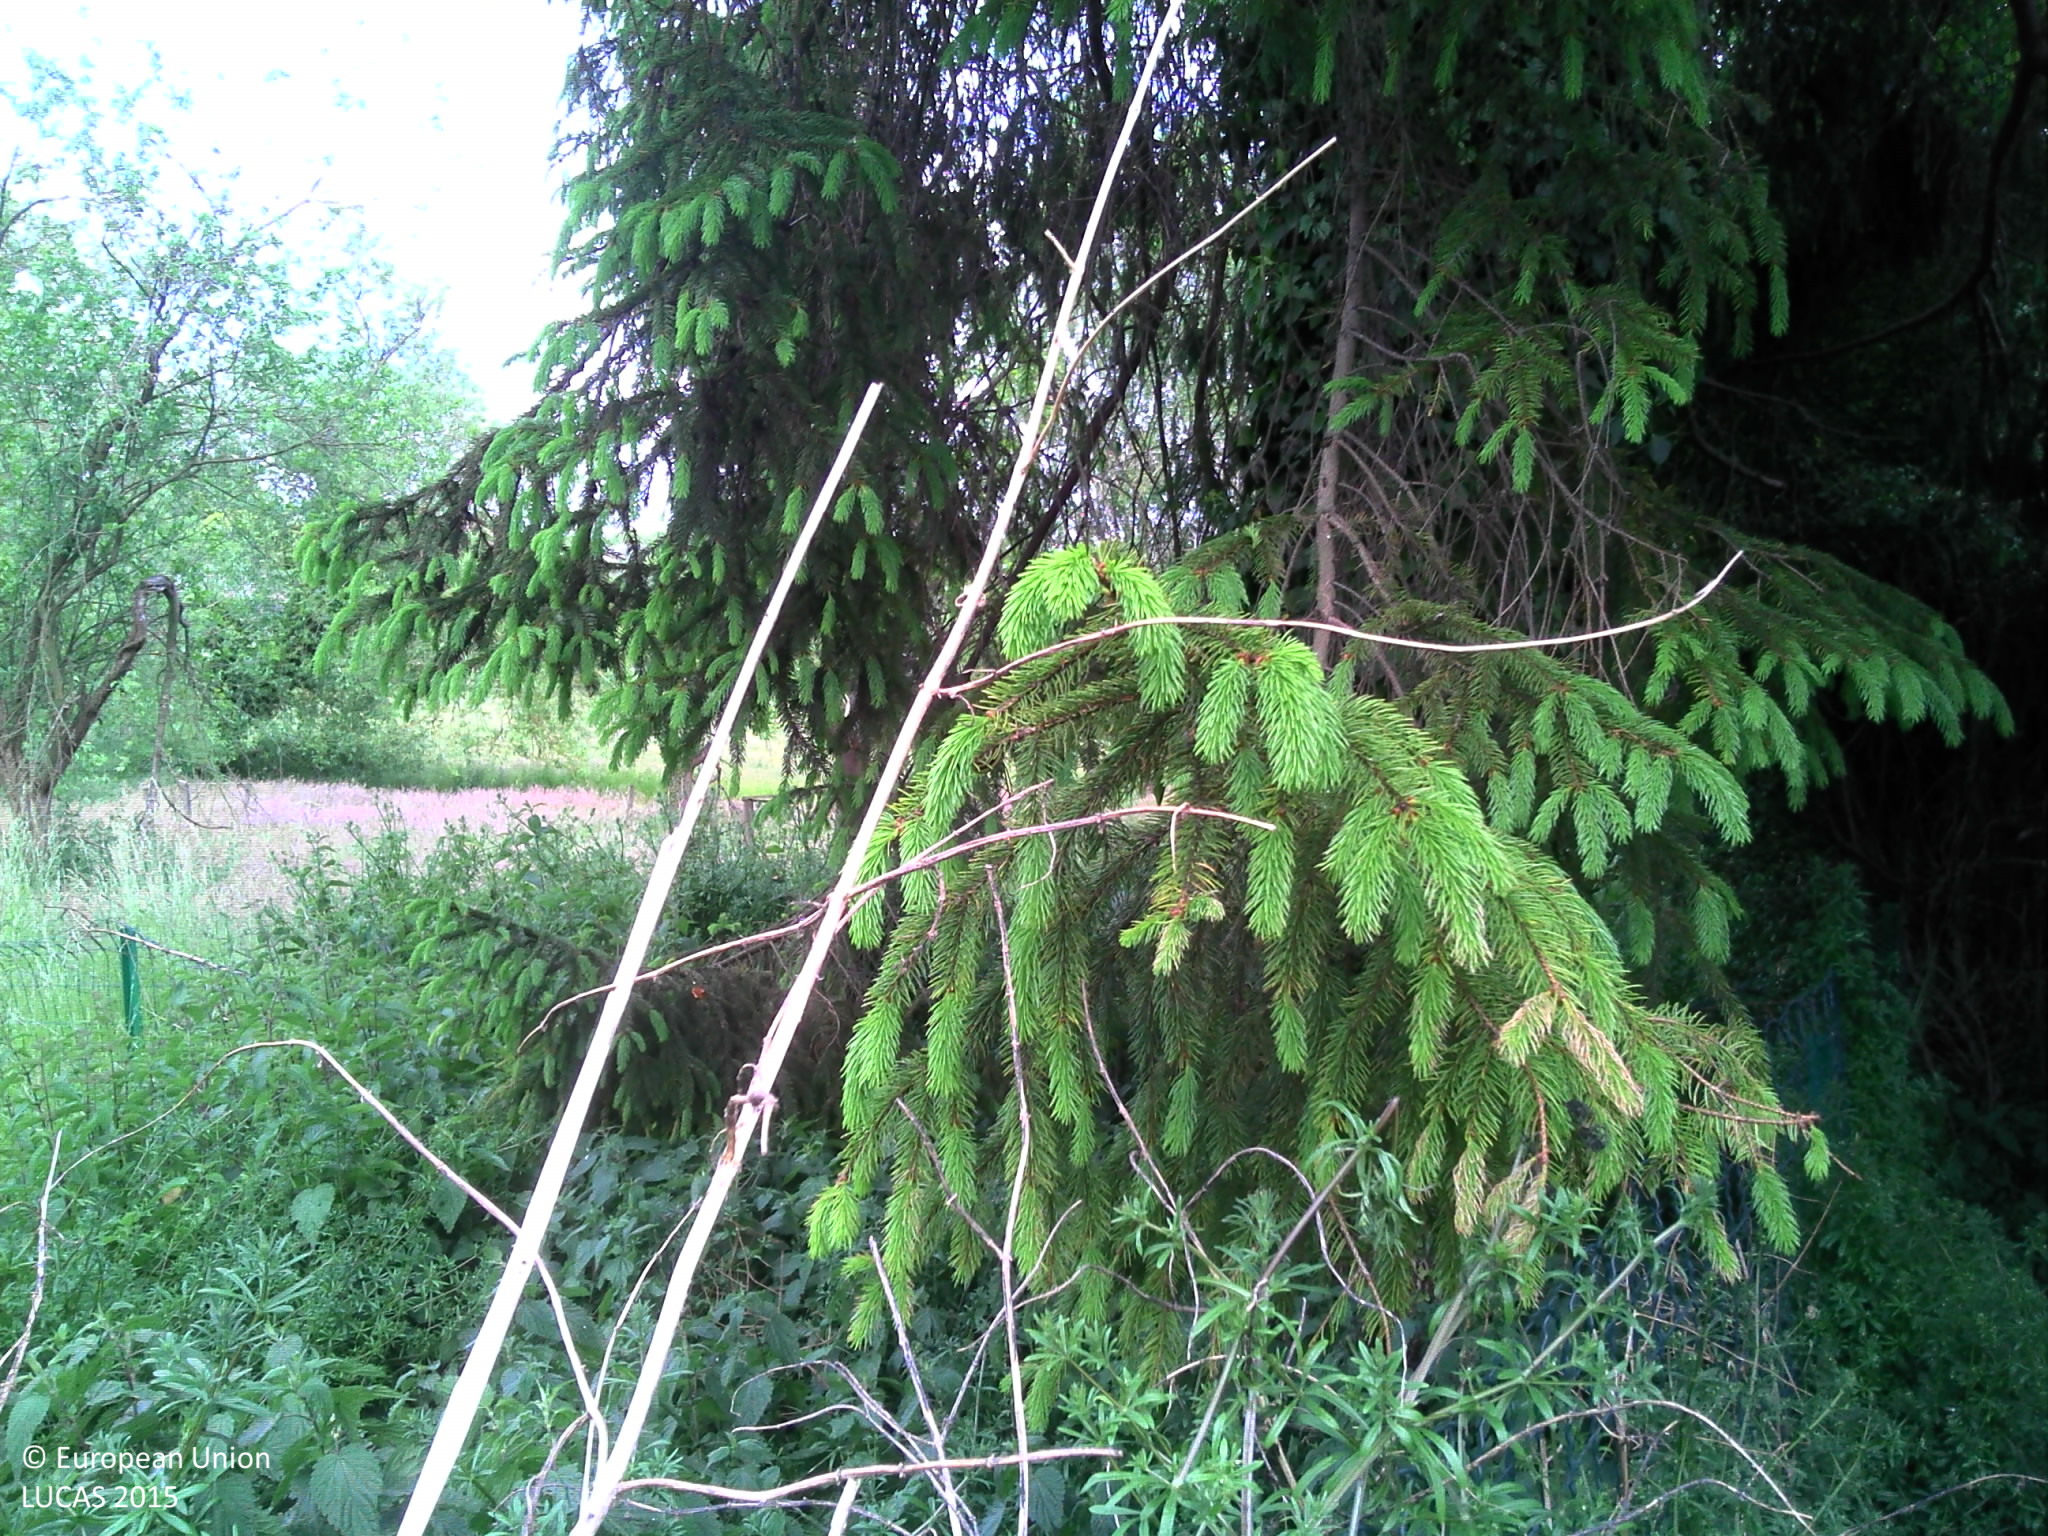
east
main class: Grassland
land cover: Grassland with sparse tree/shrub cover
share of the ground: > 75 %
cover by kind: herbaceous plants 95 %, broadleaved forest trees 5 %
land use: Agriculture (excluding fallow land and kitchen gardens)
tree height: > 5 m
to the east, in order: Grassland with sparse tree/shrub cover; Abandoned hedges; Grassland without tree/shrub cover; Fences; Spontaneously vegetated surfaces; Abandoned hedges; Artificial constructions in urban areas; Broadleaved woodland; Grassland without tree/shrub cover
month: June
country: BE
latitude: 50.5485
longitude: 5.1285
